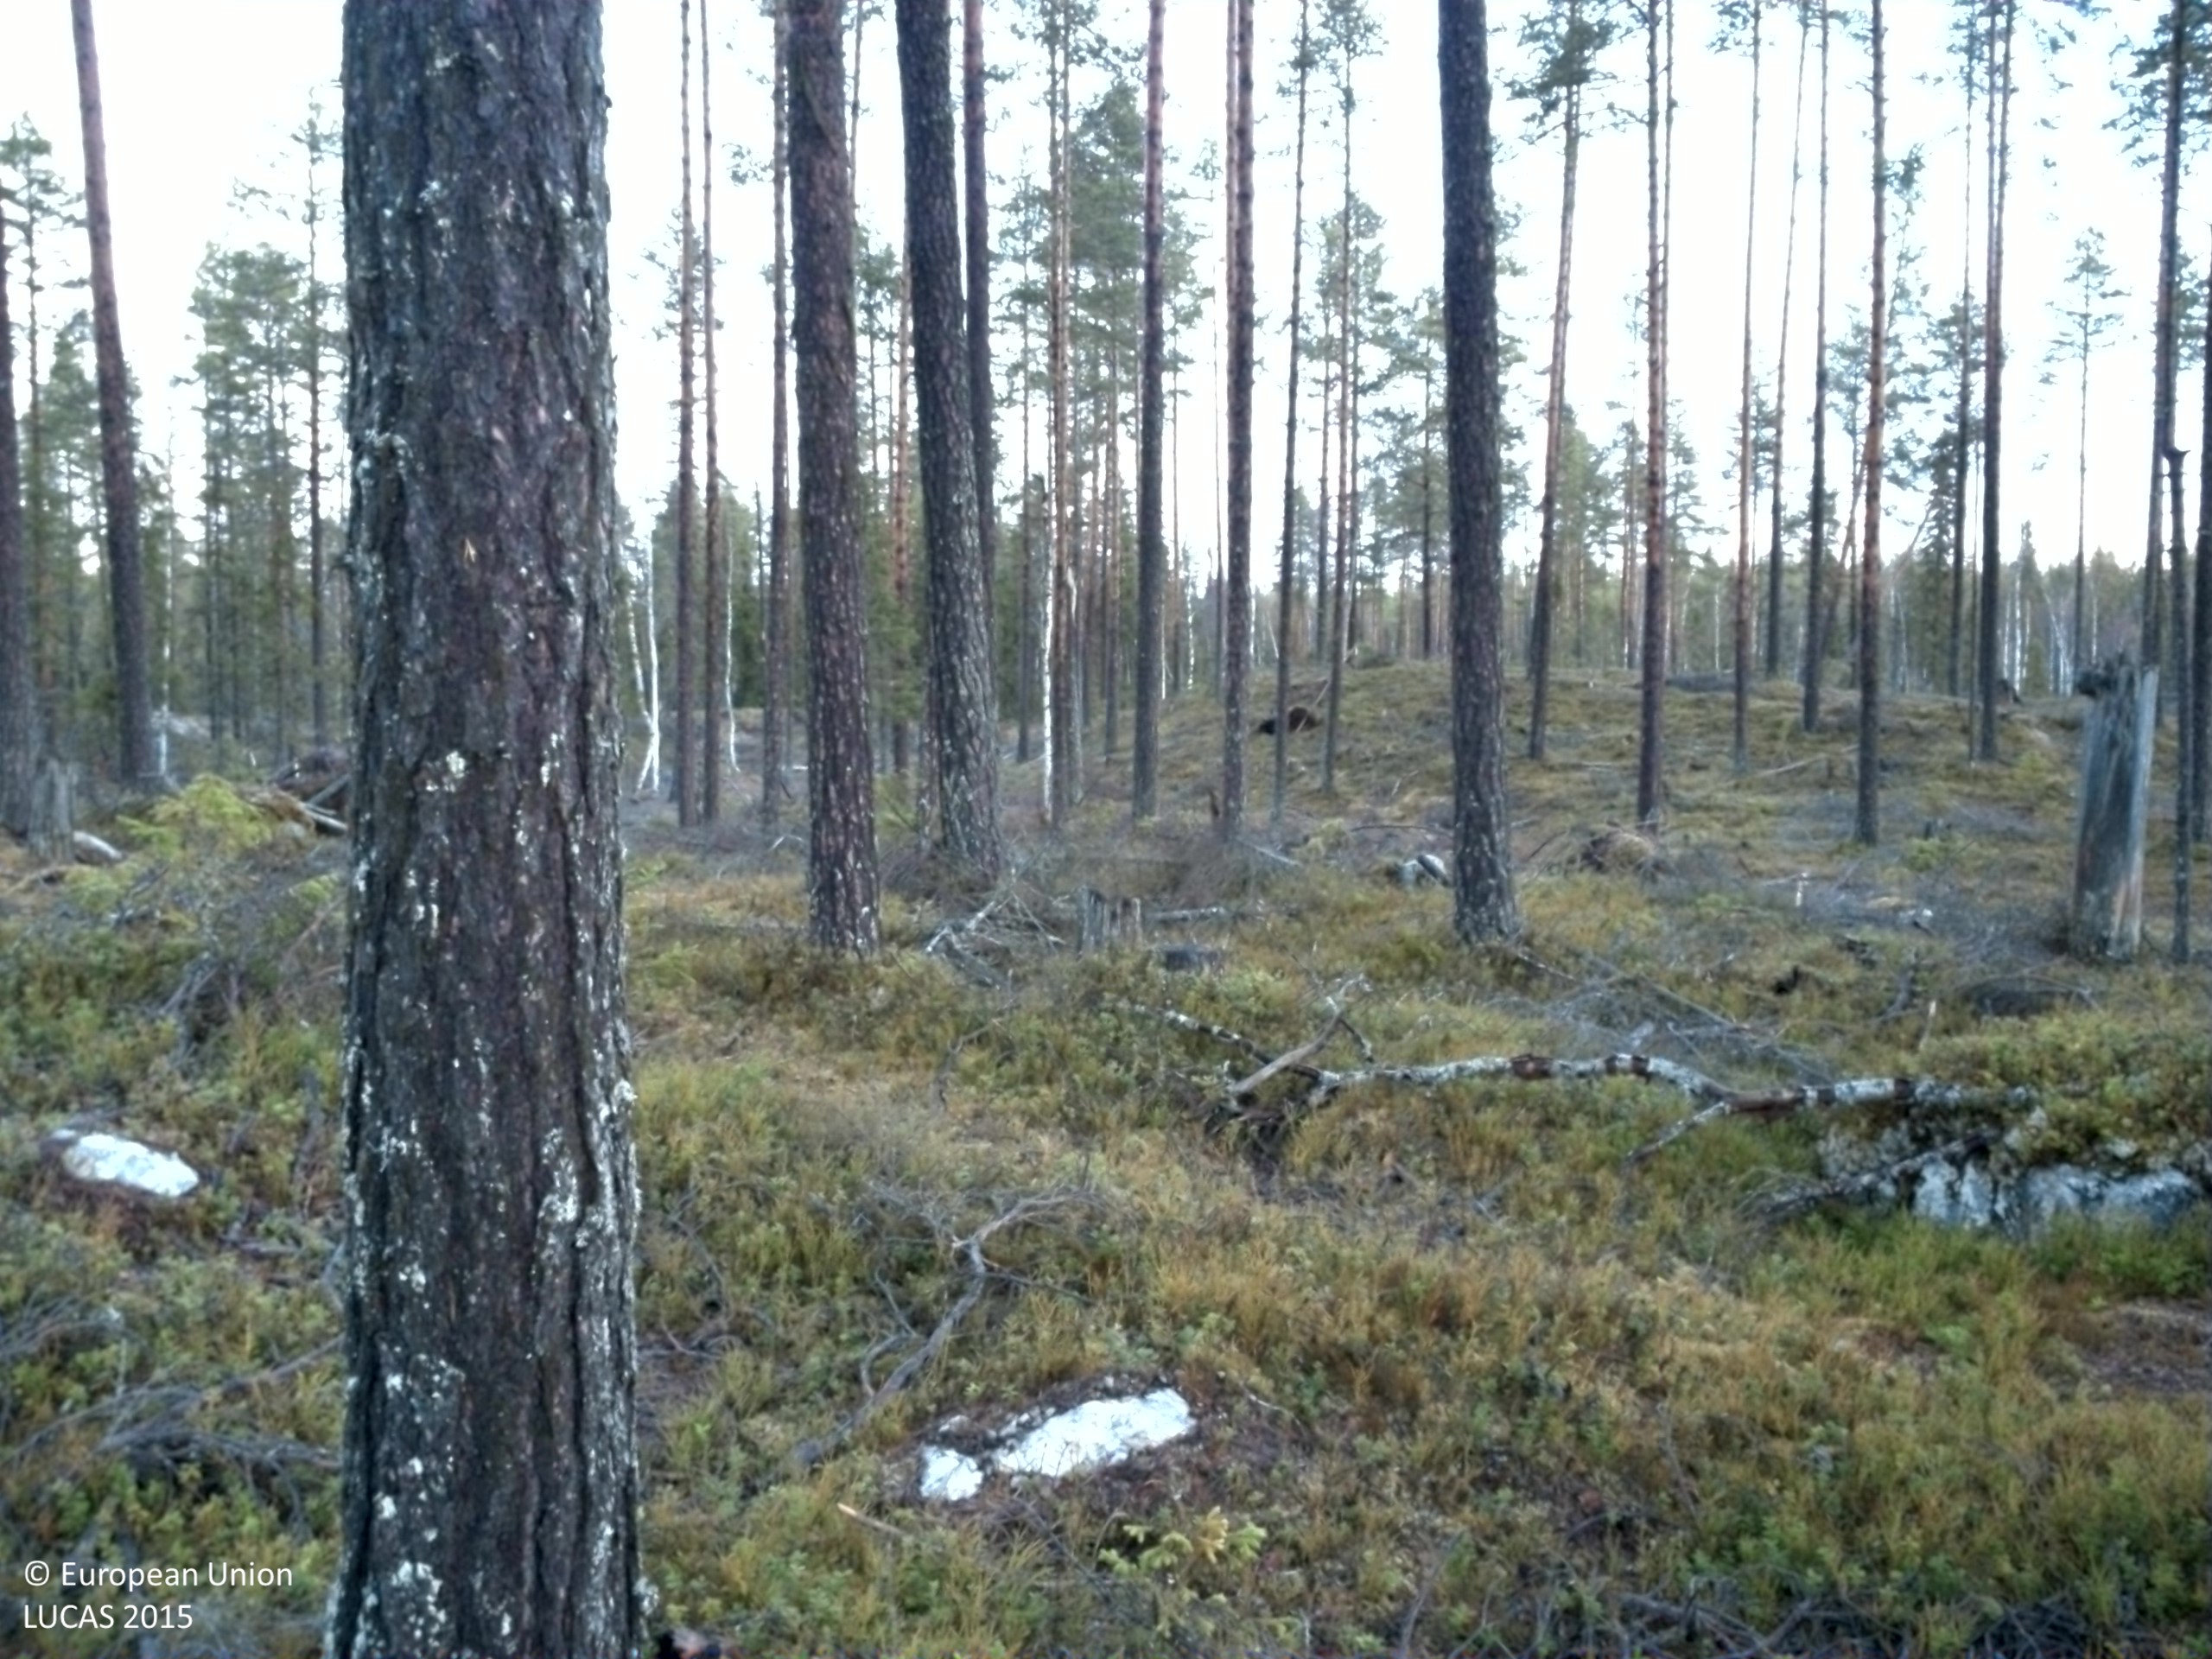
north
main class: Woodland
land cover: Pine dominated coniferous woodland
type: boreal forest
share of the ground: 25 - 50 %
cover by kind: shrubs 50 %, coniferous forest trees 25 %, lichens and mosses 20 %, broadleaved forest trees 5 %
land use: Forestry
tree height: > 5 m
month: November
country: SE
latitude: 63.8940
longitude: 16.2657
